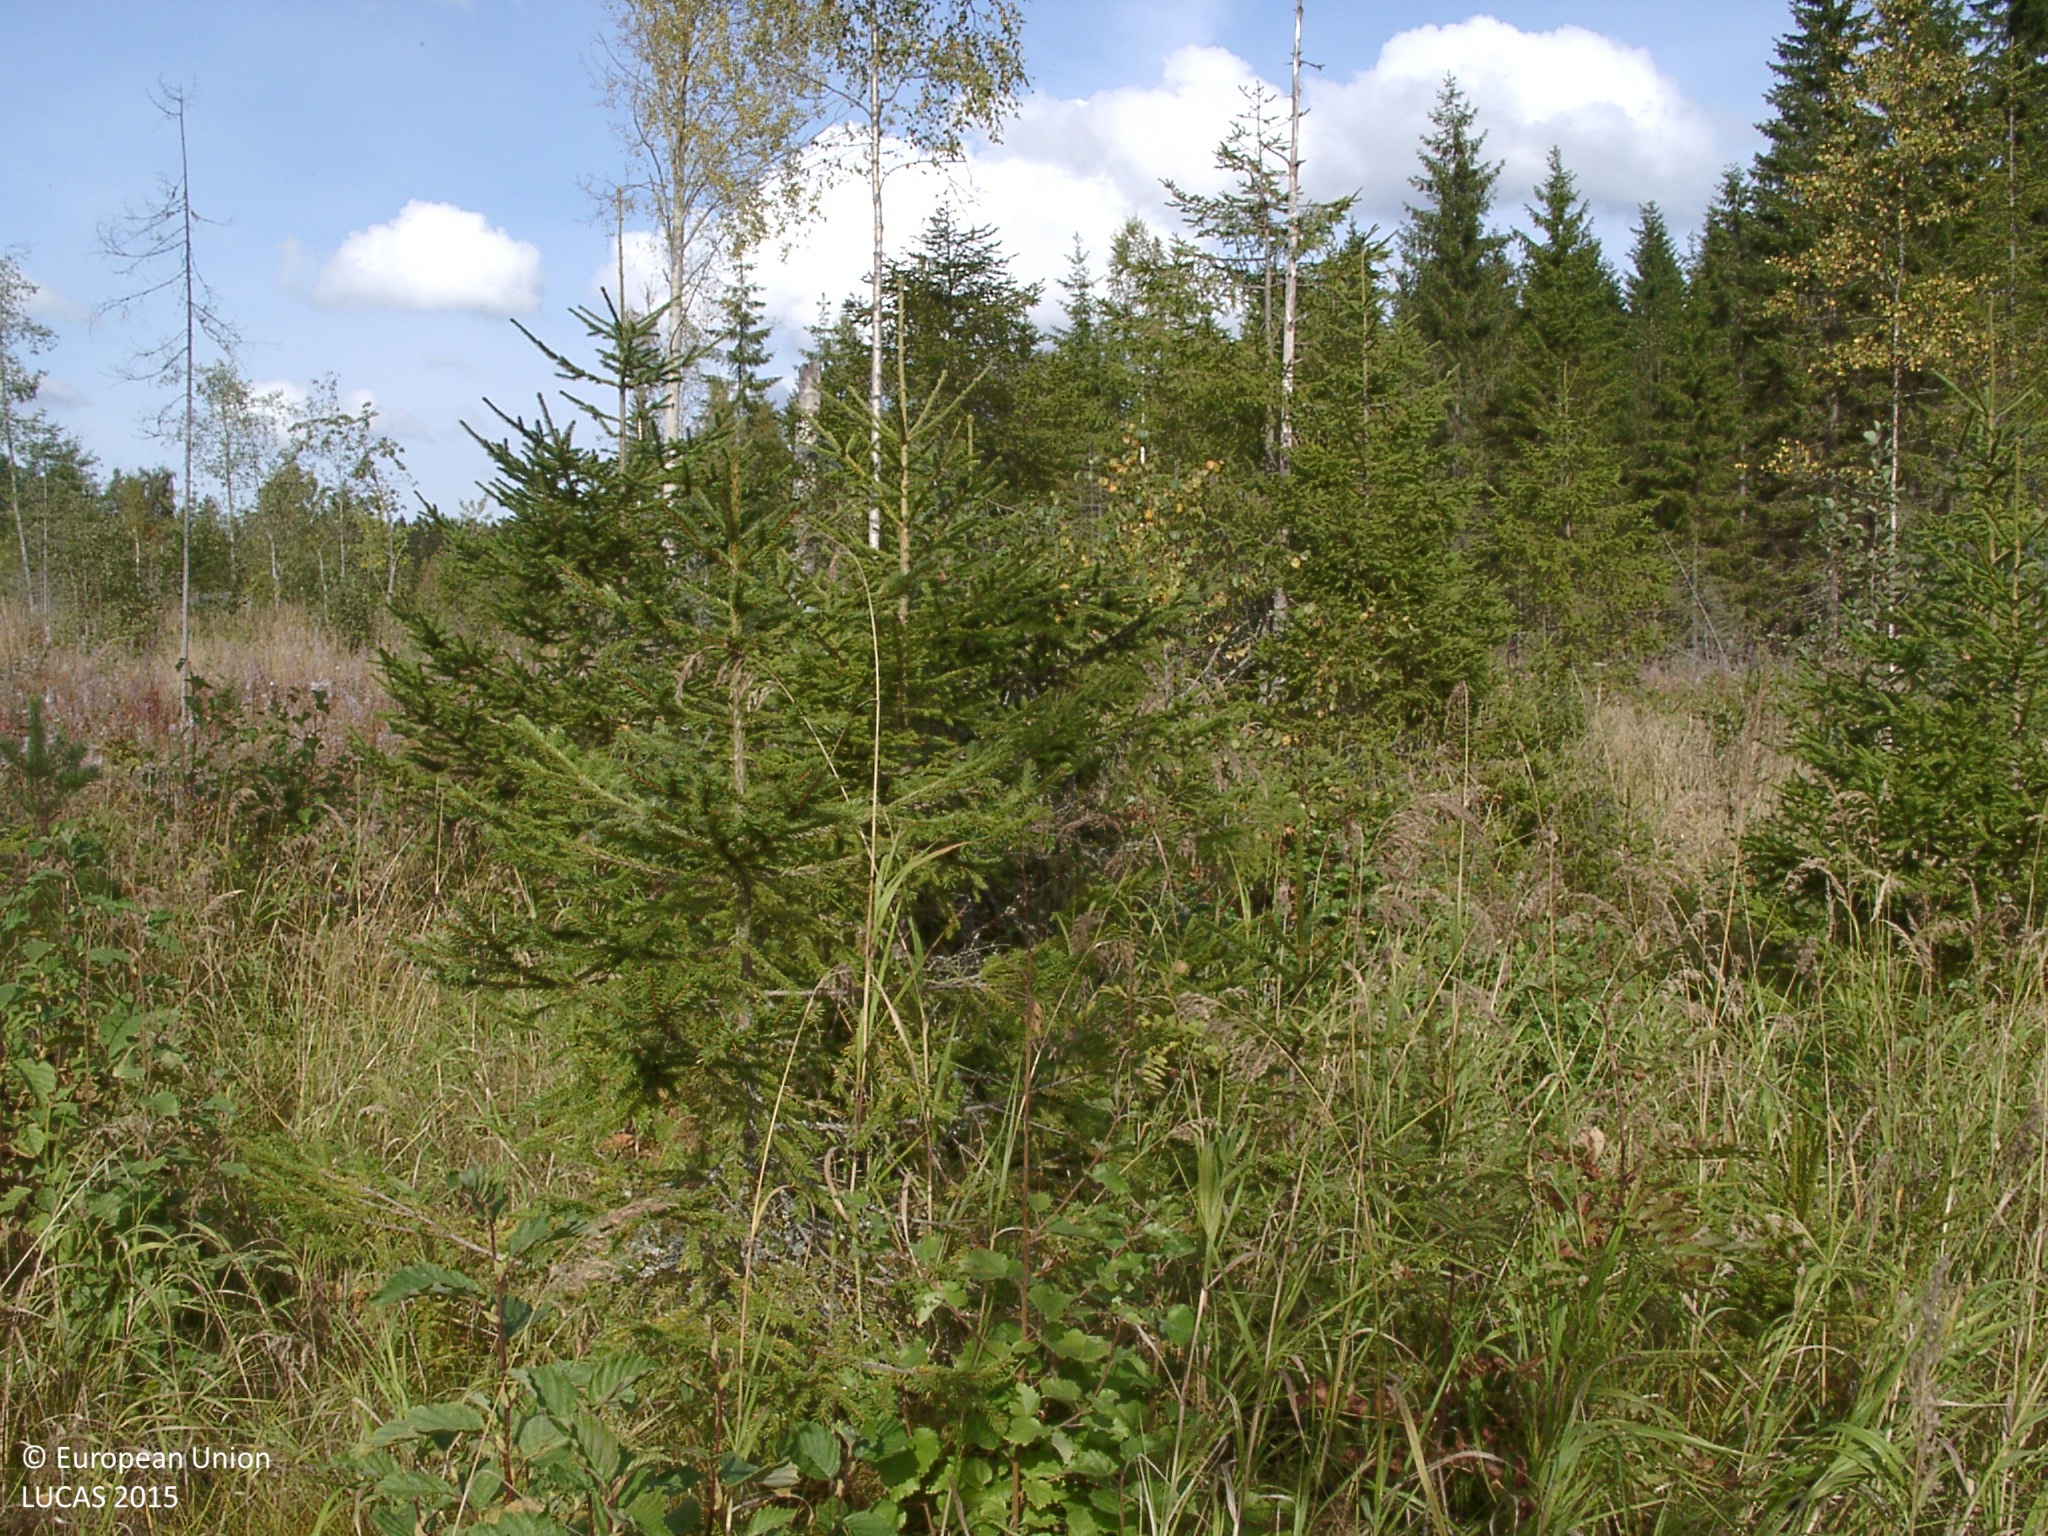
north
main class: Woodland
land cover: Spruce dominated mixed woodland
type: boreal forest
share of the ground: 10 - 25 %
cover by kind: herbaceous plants 75 %, lichens and mosses 10 %, coniferous forest trees 5 %, broadleaved forest trees 5 %, shrubs 5 %
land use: Forestry
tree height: < 5 m
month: September
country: FI
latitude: 62.5231
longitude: 25.8367
